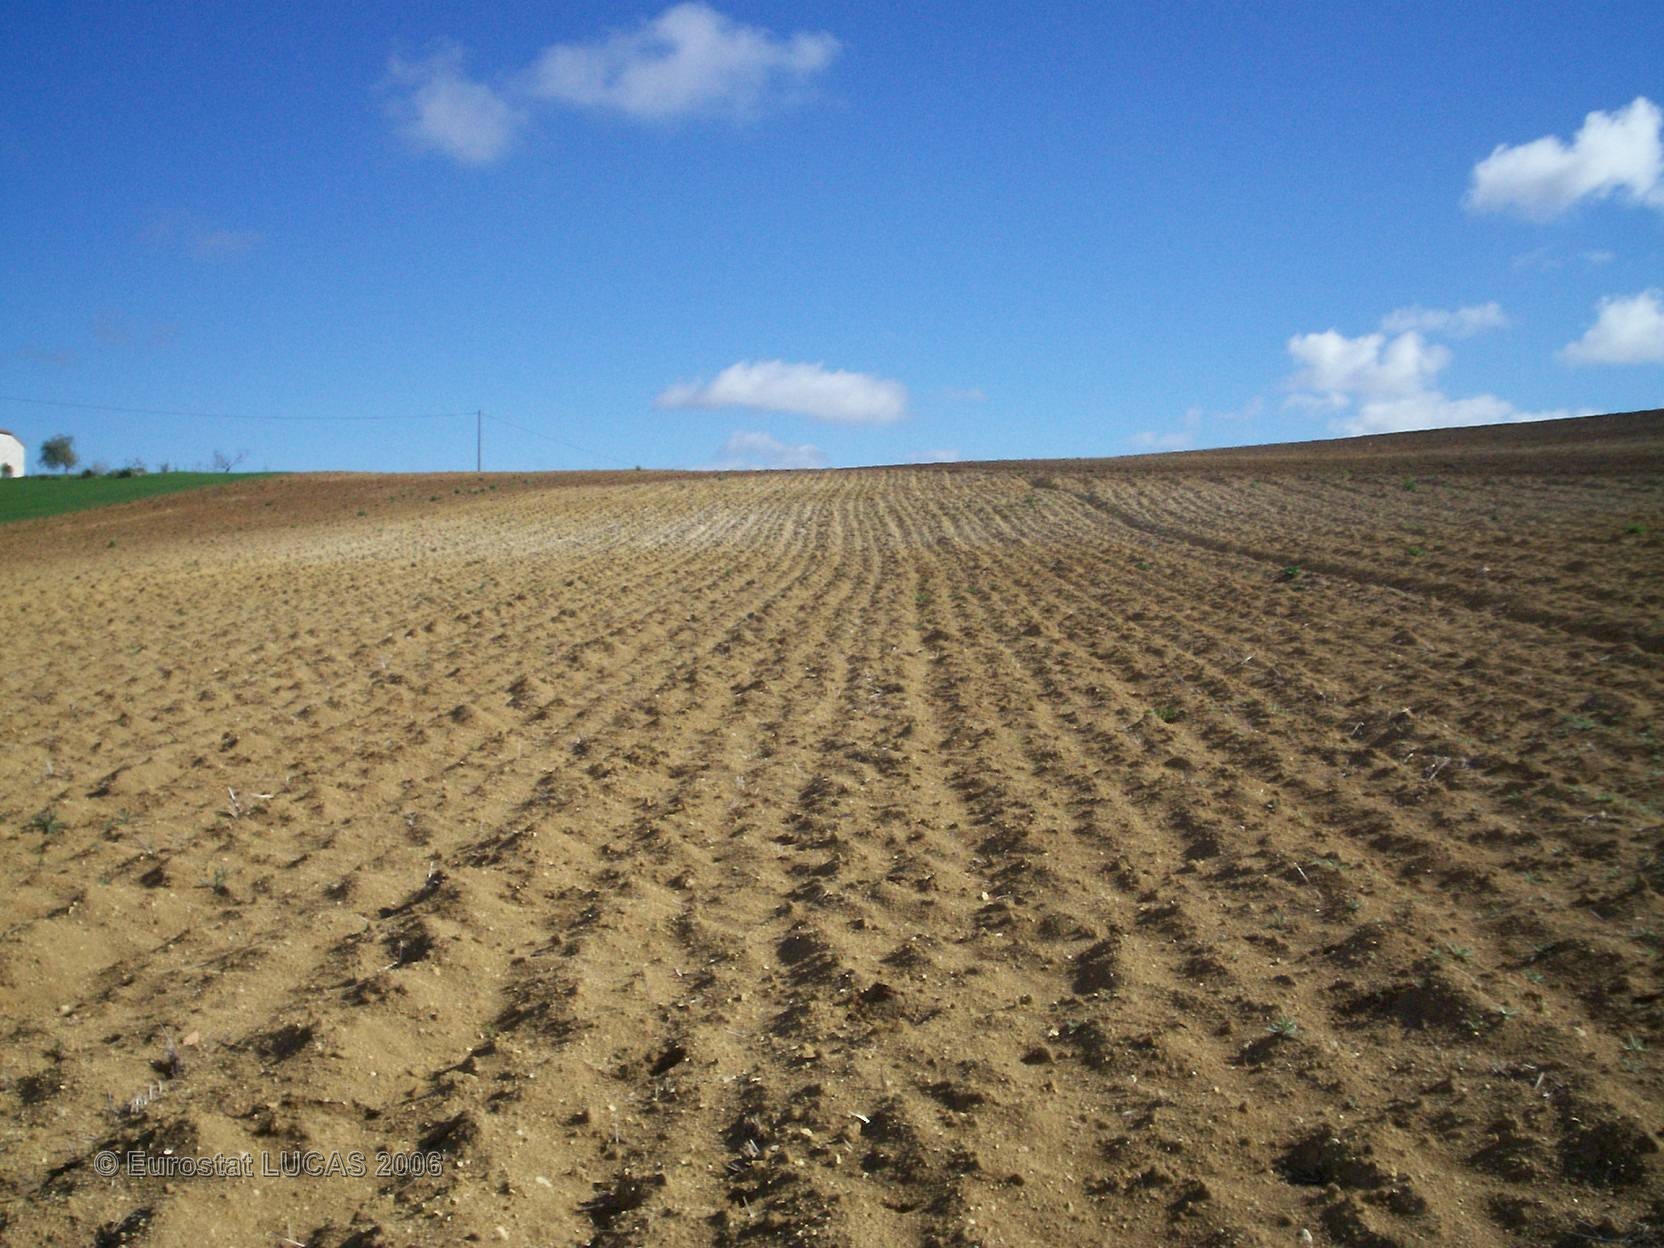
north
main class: Cropland
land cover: Sunflower
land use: Agriculture (excluding fallow land and kitchen gardens)
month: June
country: FR
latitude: 44.1838
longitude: 0.8769
